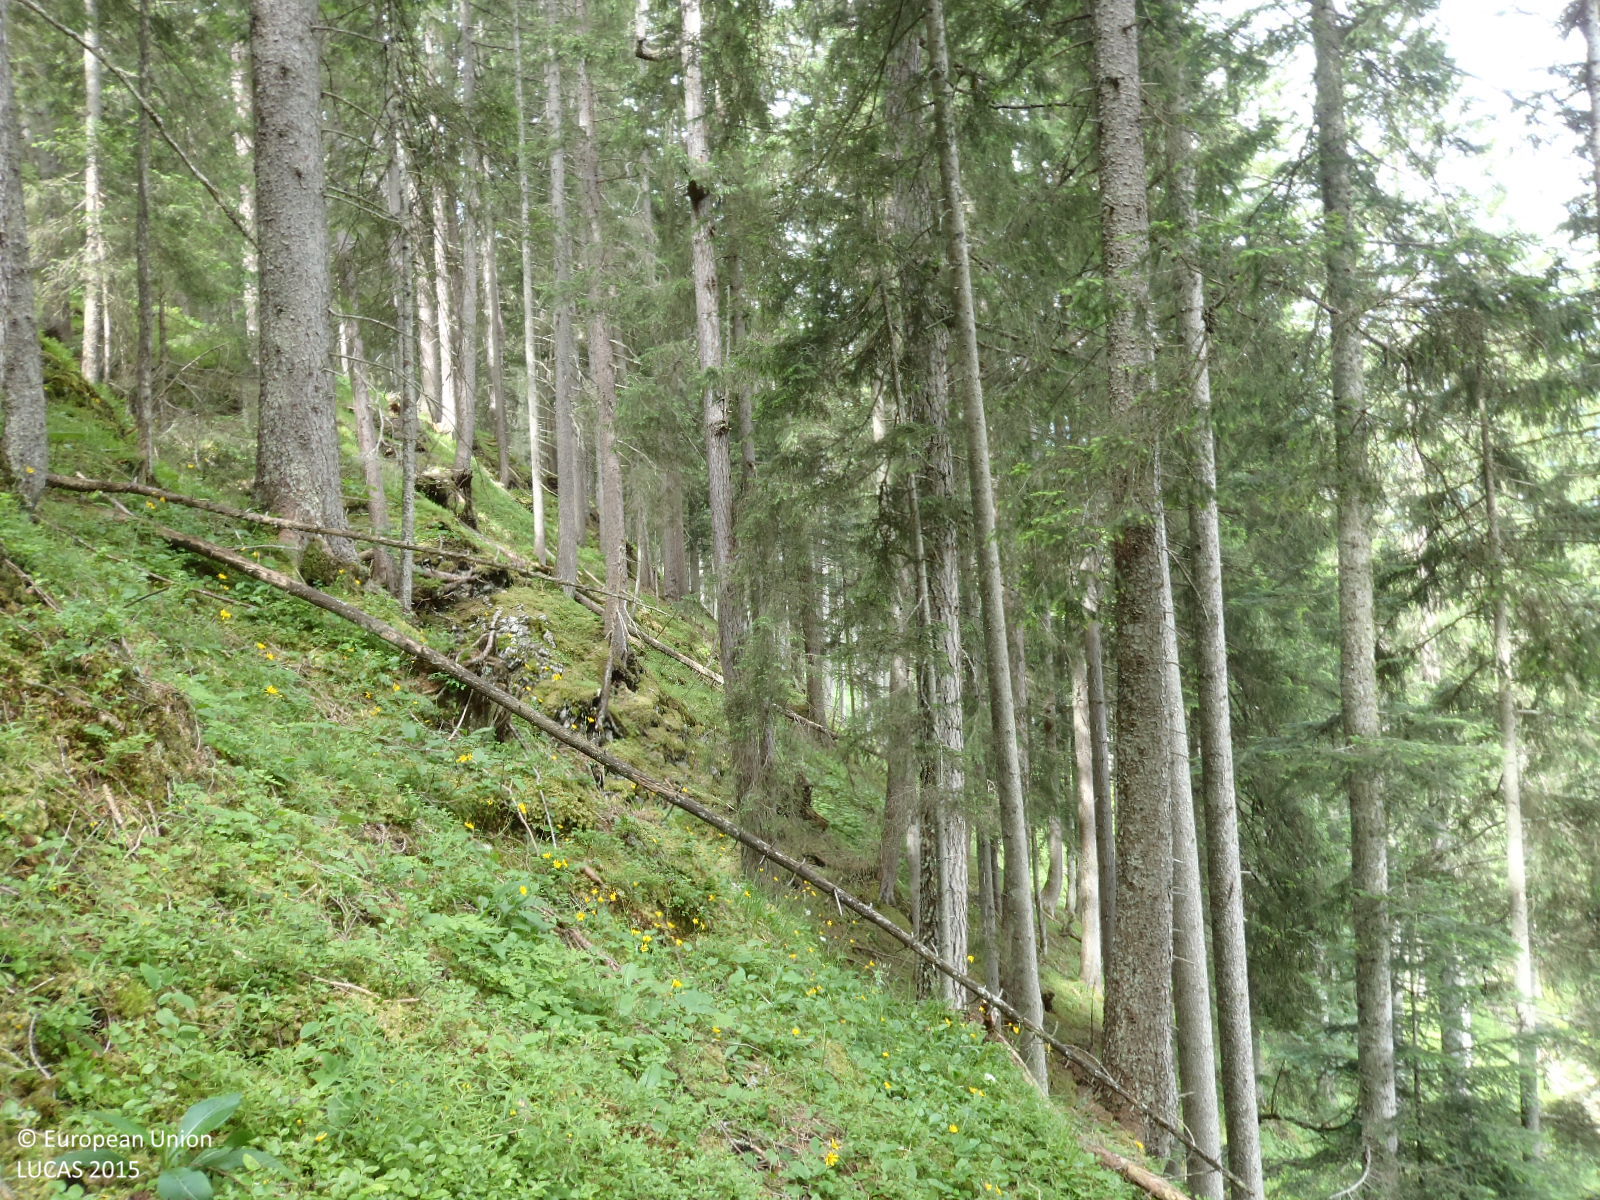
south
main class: Woodland
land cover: Other coniferous woodland
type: alpine coniferous forest
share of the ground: > 75 %
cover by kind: coniferous forest trees 80 %, shrubs 10 %, herbaceous plants 10 %
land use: Forestry
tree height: > 5 m
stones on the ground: < 10 %
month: June
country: AT
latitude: 47.2866
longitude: 10.4623
